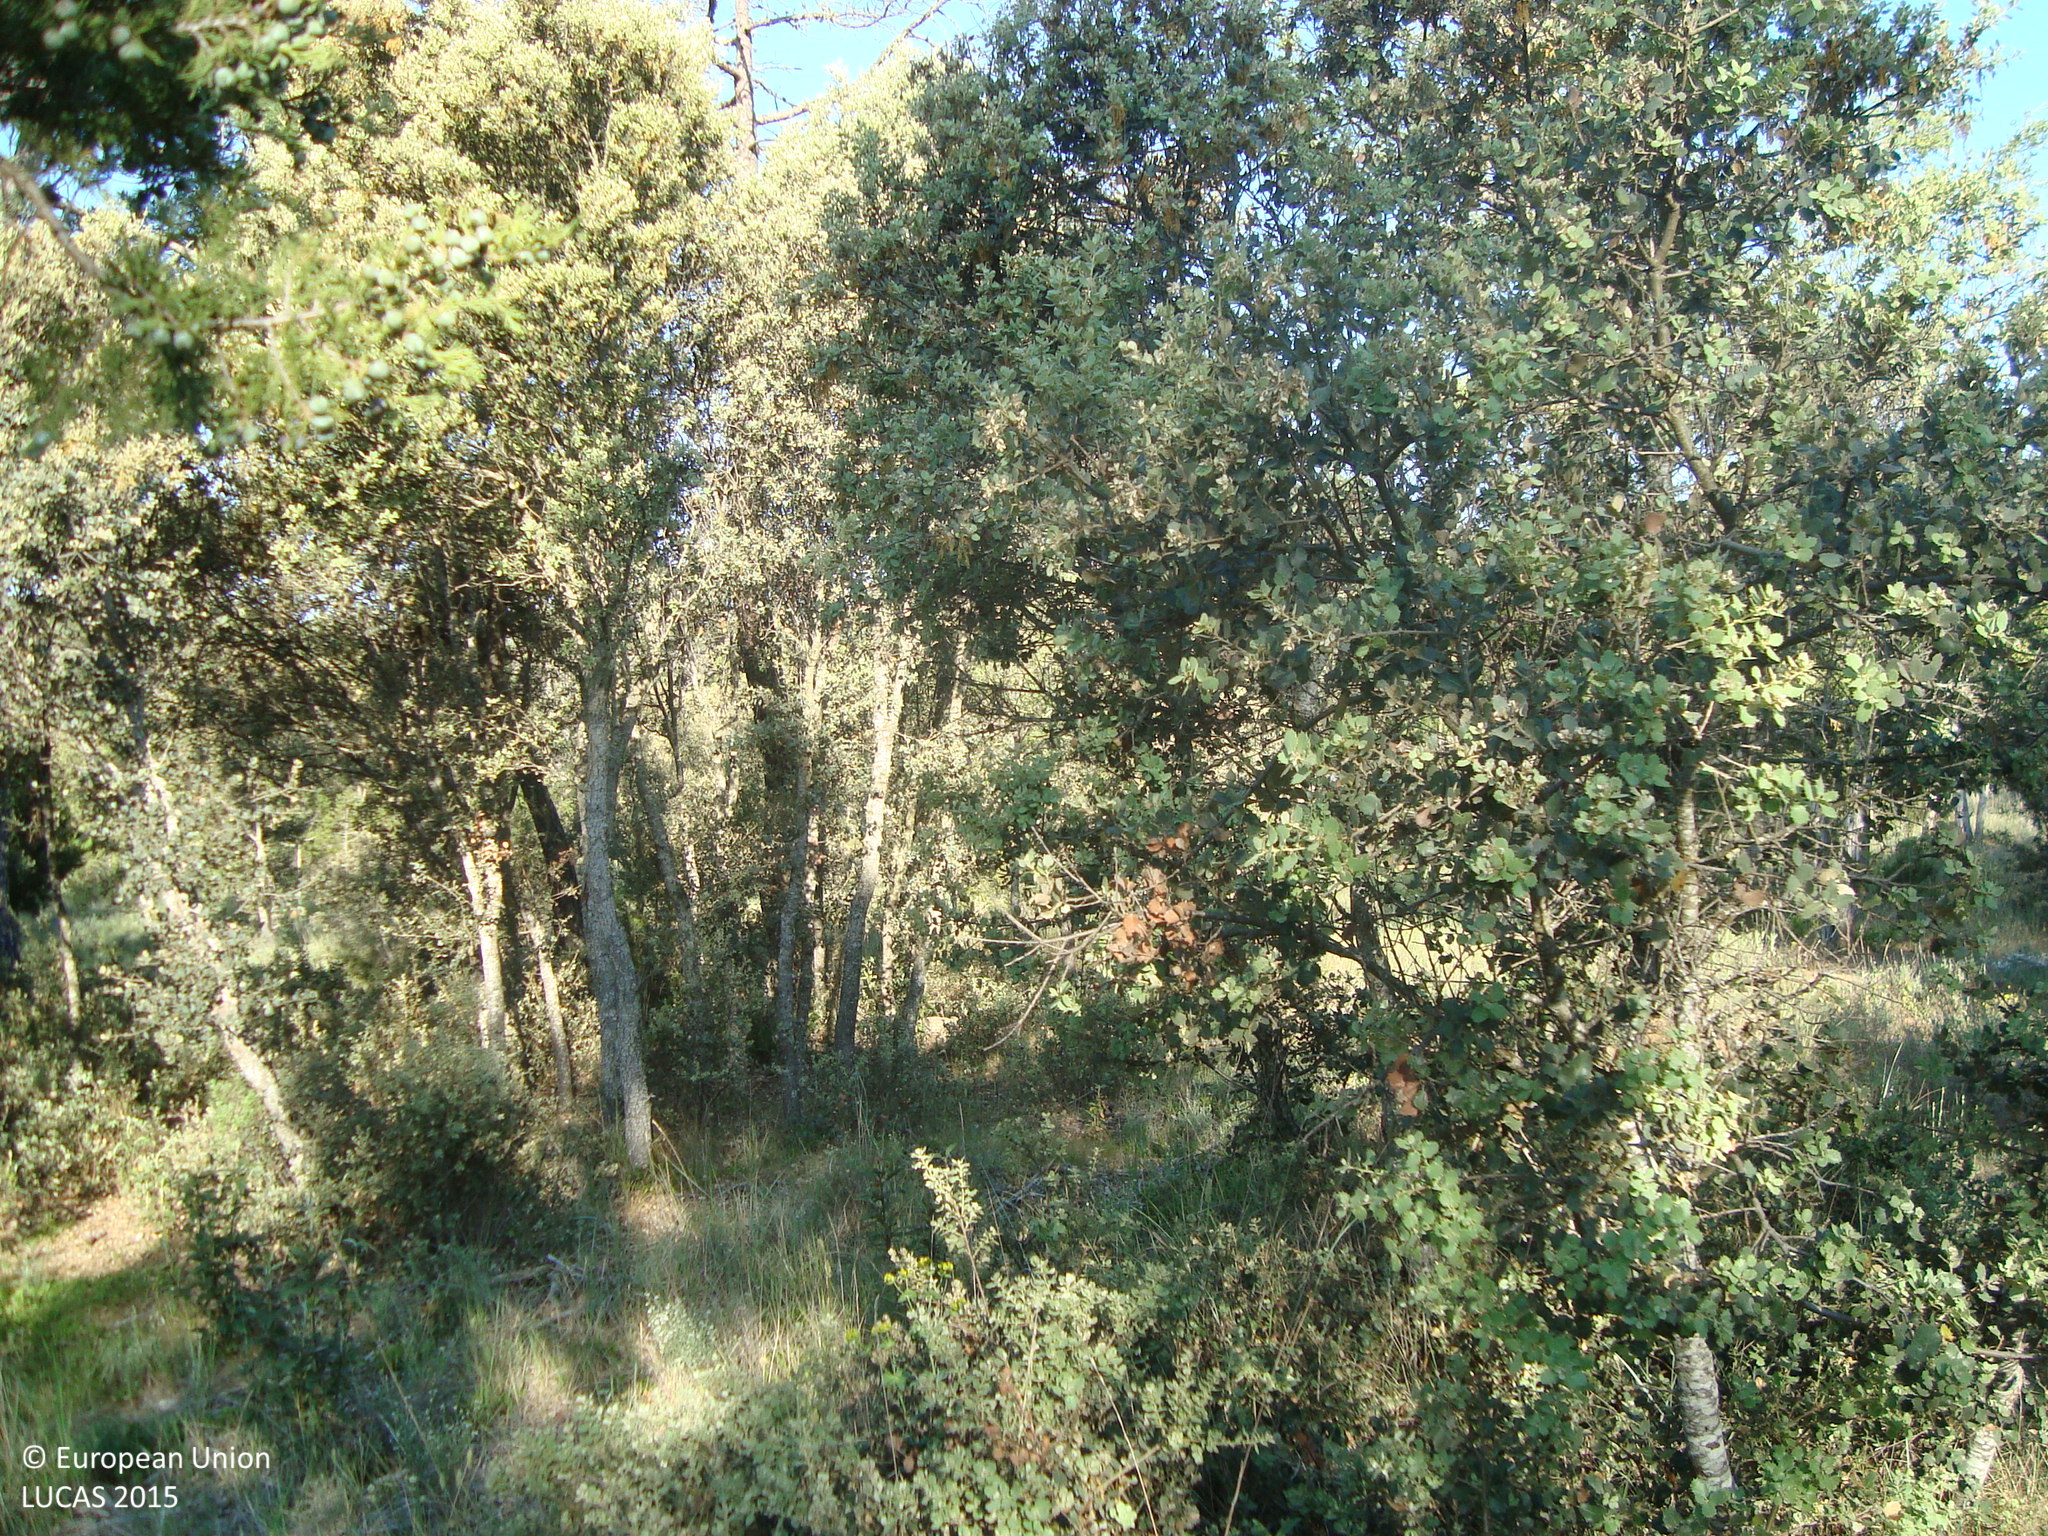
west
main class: Woodland
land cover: Pine dominated mixed woodland
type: coniferous forest of the mediterranean region
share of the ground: 50 - 75 %
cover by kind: broadleaved forest trees 40 %, coniferous forest trees 30 %, shrubs 20 %, herbaceous plants 5 %, unconsolidated bare surface 5 %
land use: Forestry
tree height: > 5 m
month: June
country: ES
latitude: 41.7672
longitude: -3.6095
